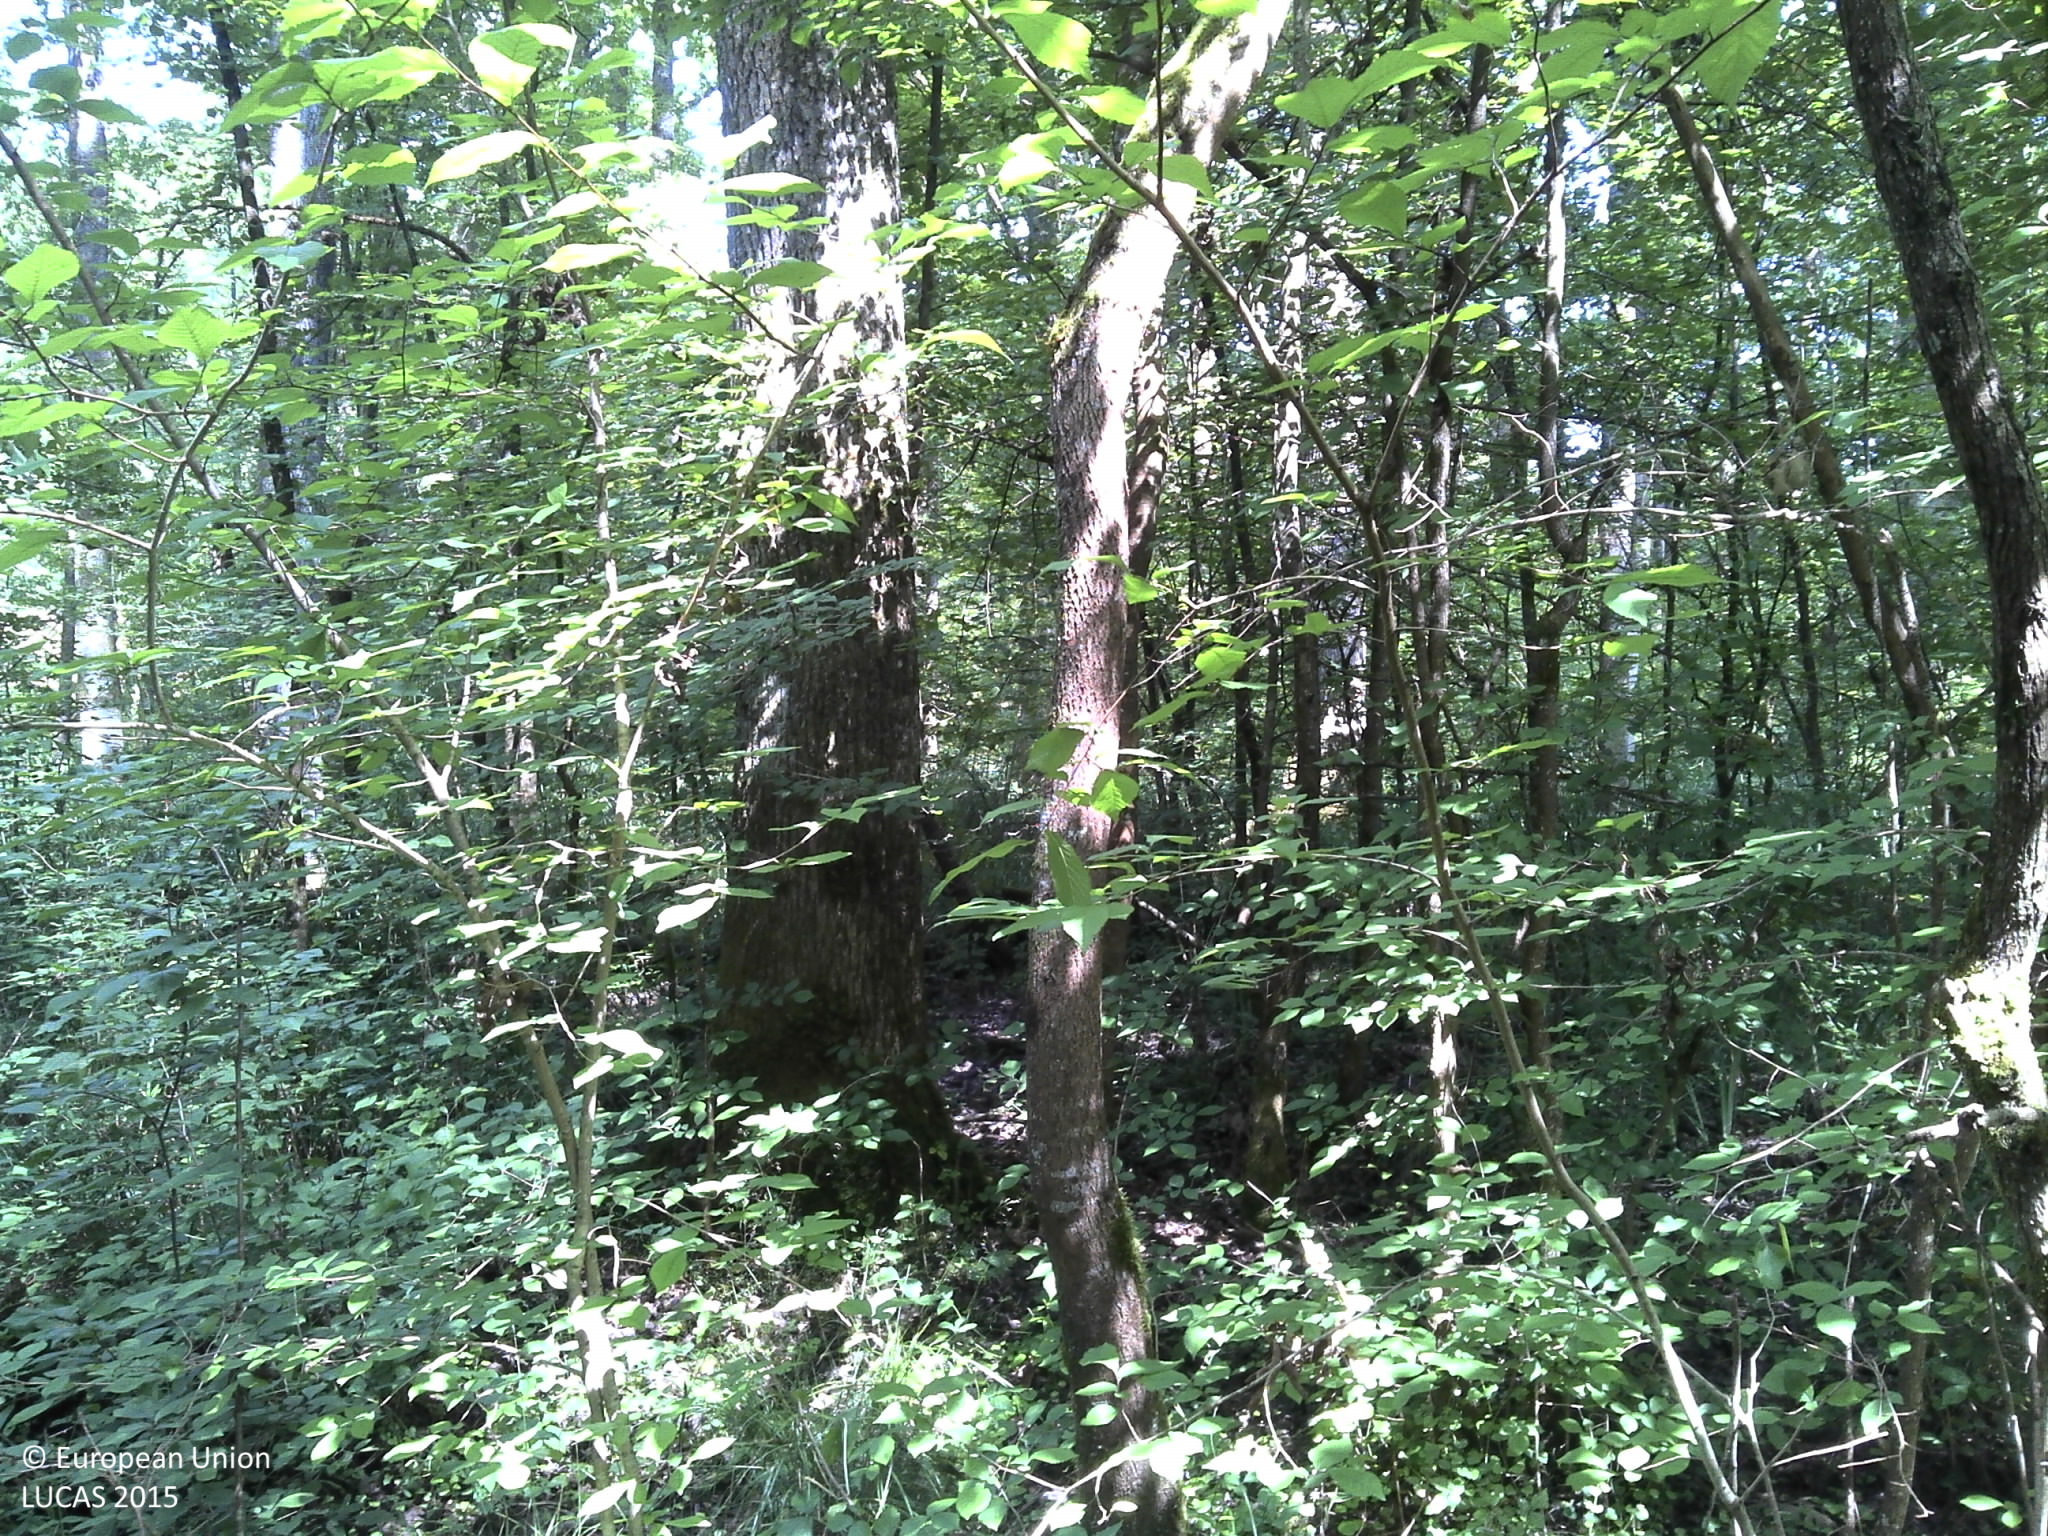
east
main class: Woodland
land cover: Broadleaved woodland
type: acidophilous oak and oak-birch forest
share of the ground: > 75 %
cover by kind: broadleaved forest trees 80 %, lichens and mosses 20 %
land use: Forestry
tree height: > 5 m
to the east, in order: Broadleaved woodland; Grassland without tree/shrub cover; Other structural elements; Grassland without tree/shrub cover; Broadleaved woodland; Paved roads, cycling and walking lanes; Broadleaved woodland
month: August
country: HR
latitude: 45.5021
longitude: 16.5125
